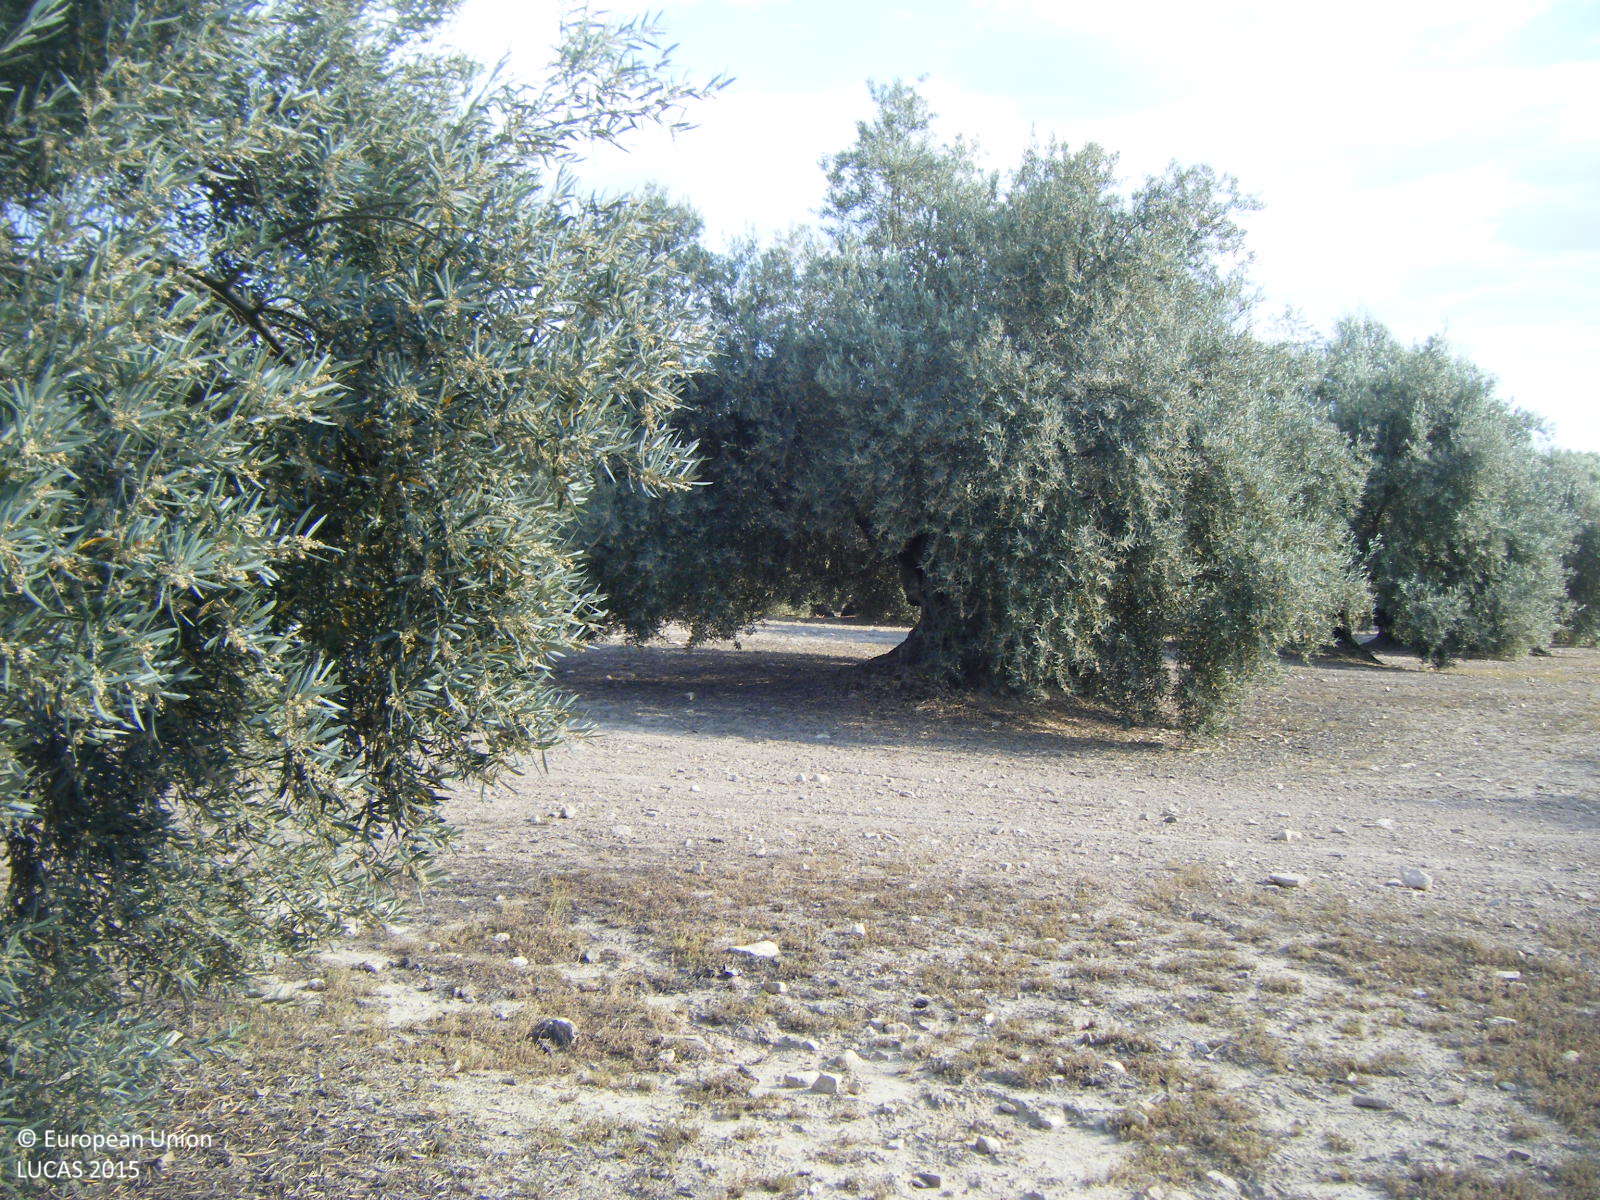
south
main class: Cropland
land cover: Olive groves
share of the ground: 10 - 25 %
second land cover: Other bare soil
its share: > 75 %
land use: Agriculture (excluding fallow land and kitchen gardens)
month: May
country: ES
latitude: 37.2424
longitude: -4.4626
